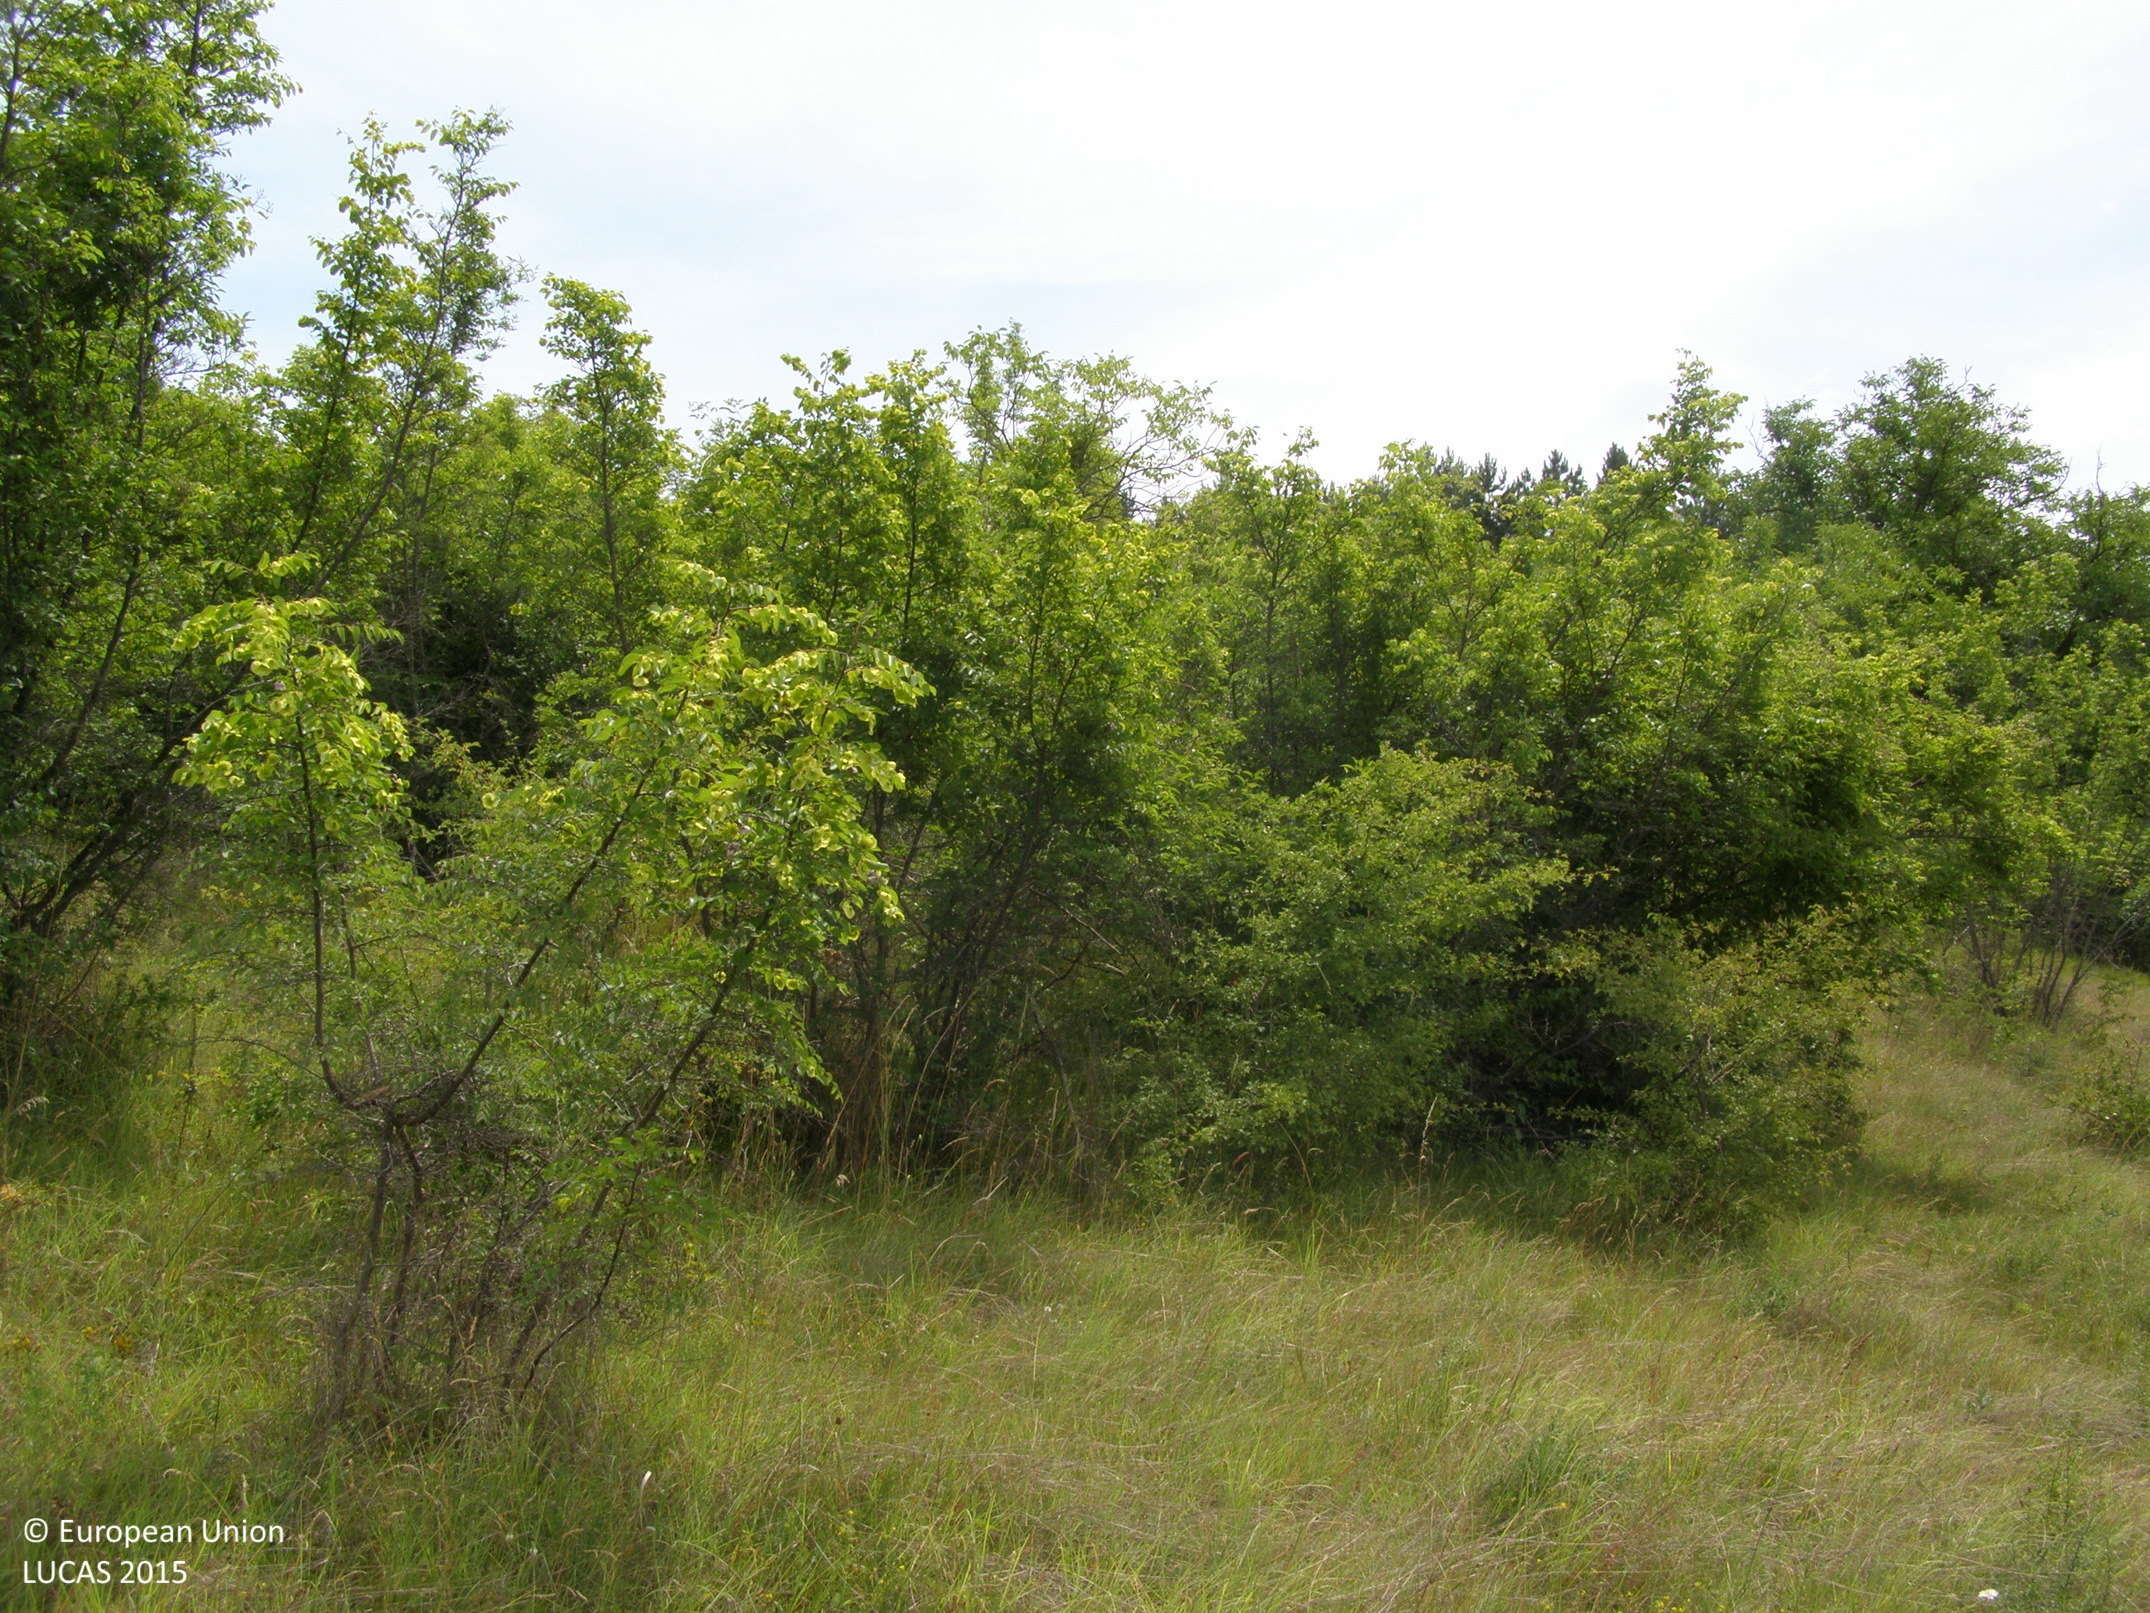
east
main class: Grassland
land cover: Grassland with sparse tree/shrub cover
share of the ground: > 75 %
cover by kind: herbaceous plants 85 %, shrubs 10 %, broadleaved forest trees 5 %
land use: Abandoned areas
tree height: < 5 m
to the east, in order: Grassland with sparse tree/shrub cover; Broadleaved woodland
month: July
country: BG
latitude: 43.2668
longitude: 27.1069
